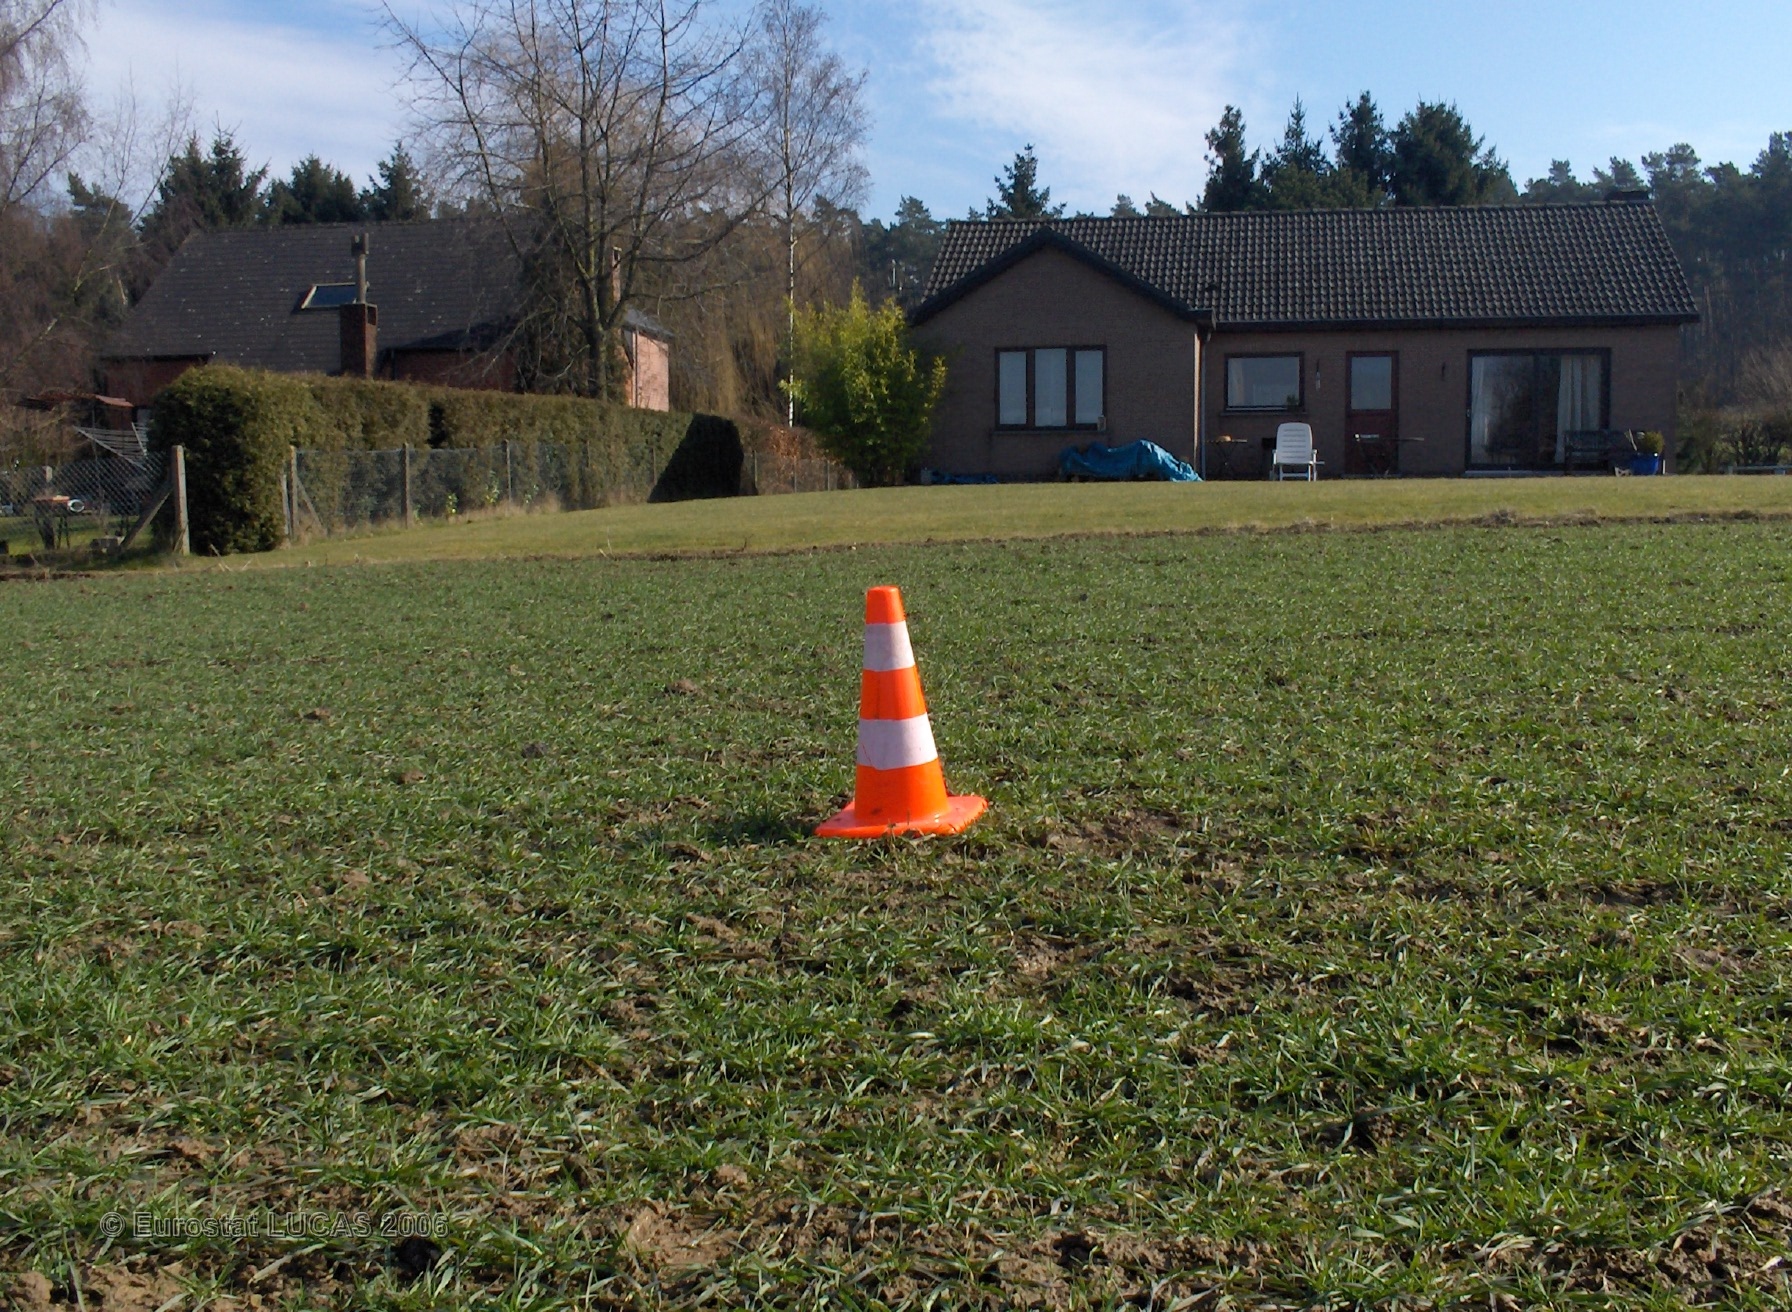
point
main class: Cropland
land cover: Common wheat
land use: Agriculture (excluding fallow land and kitchen gardens)
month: March
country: BE
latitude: 50.6129
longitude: 4.5551
